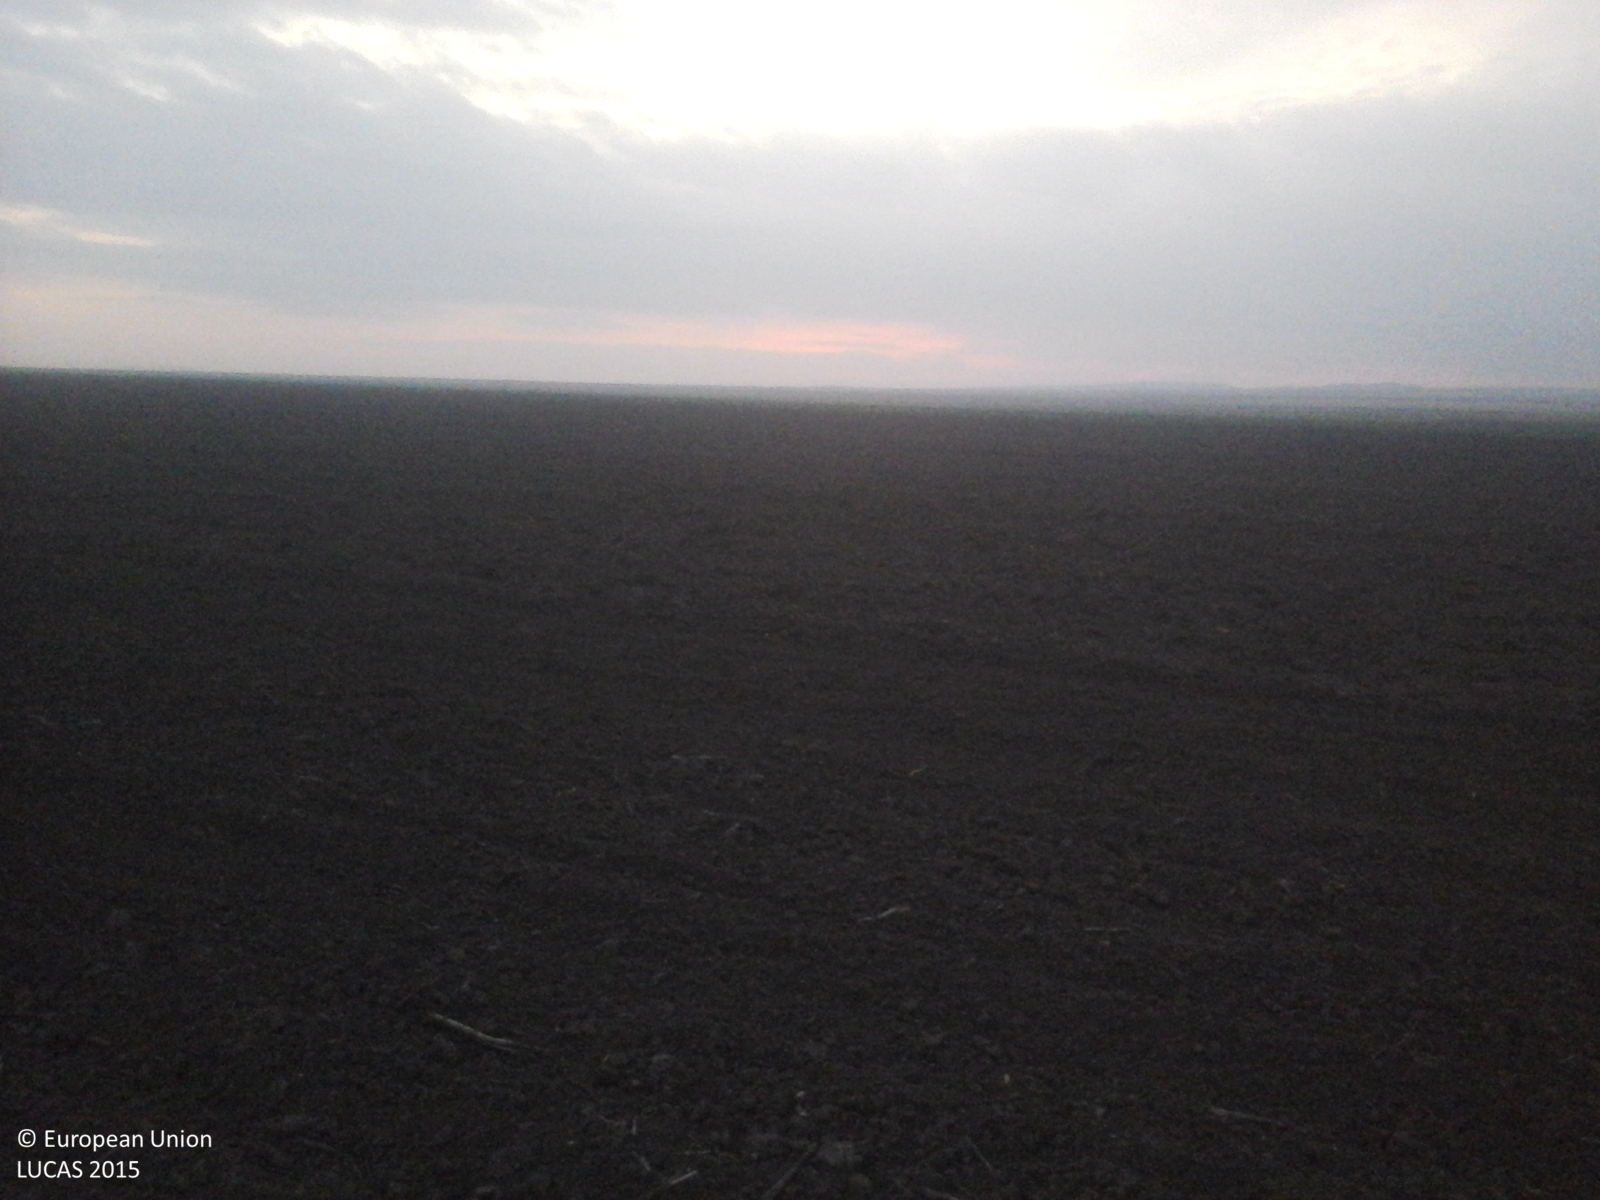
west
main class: Cropland
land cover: Maize
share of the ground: < 10 %
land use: Agriculture (excluding fallow land and kitchen gardens)
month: October
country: RO
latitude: 45.2892
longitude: 27.0057
